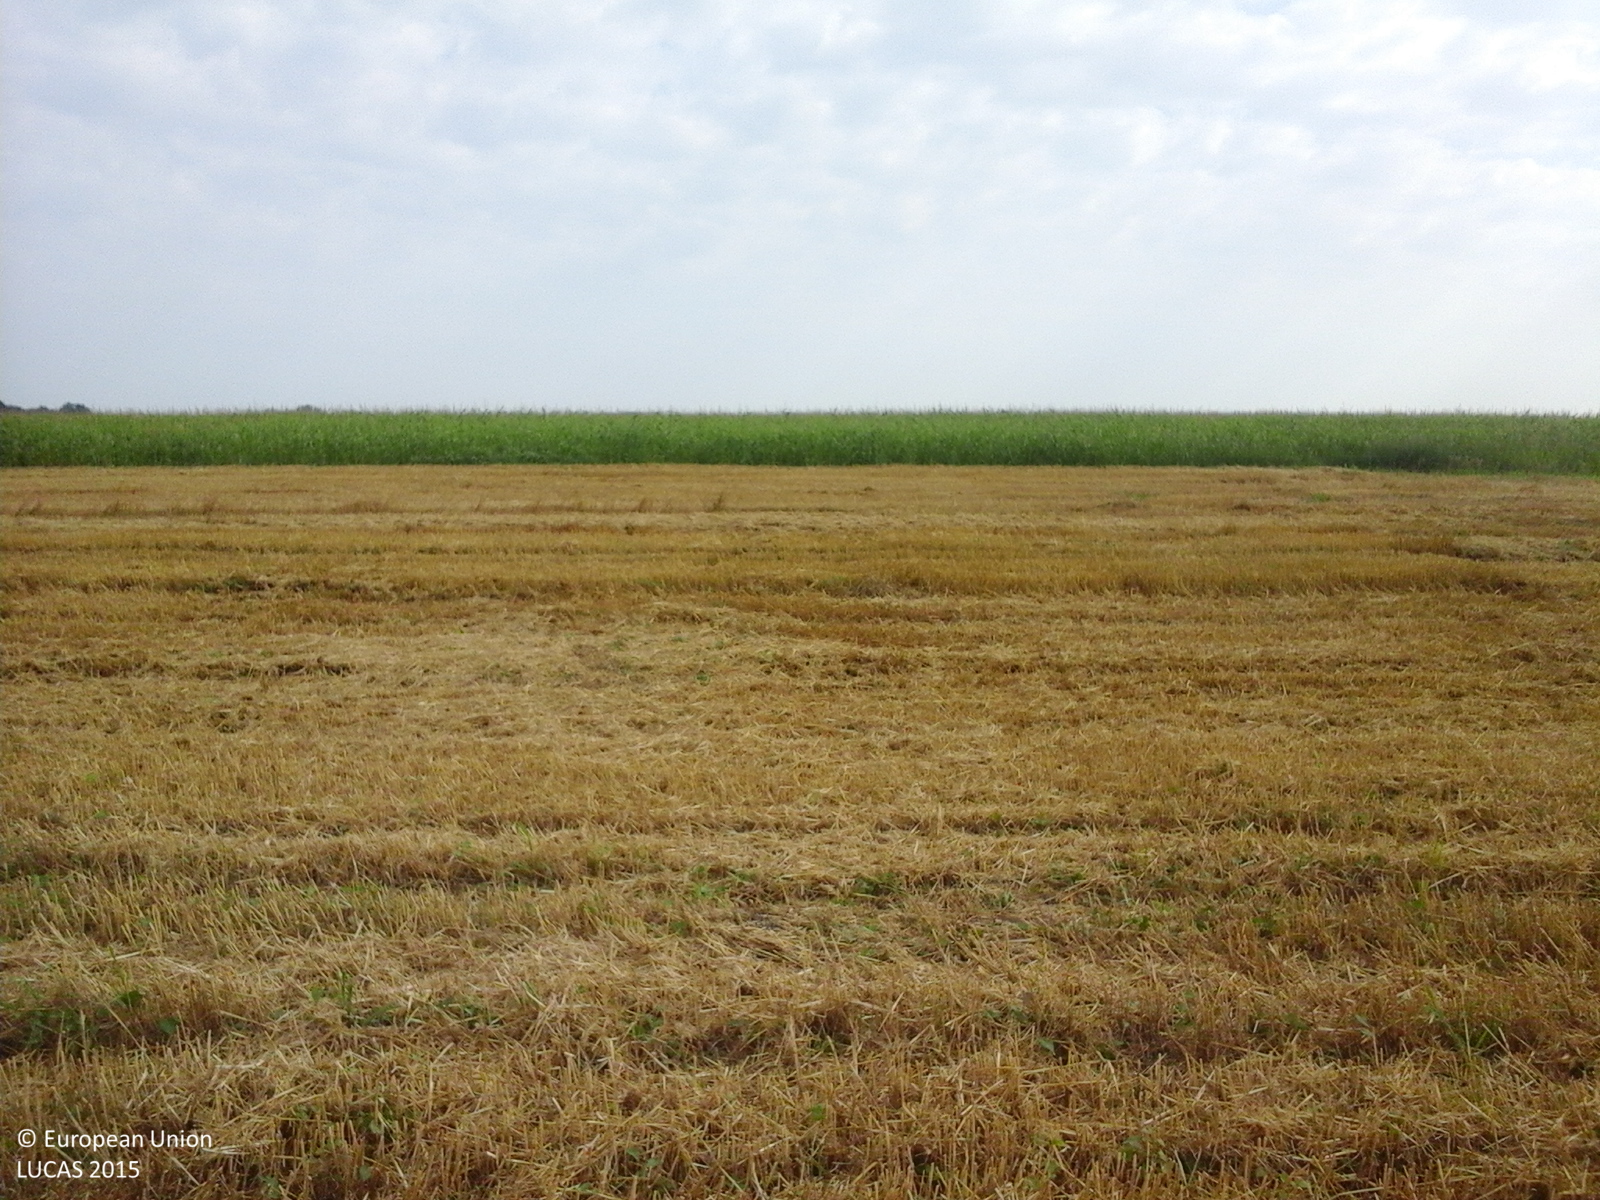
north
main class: Cropland
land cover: Durum wheat
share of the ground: < 10 %
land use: Agriculture (excluding fallow land and kitchen gardens)
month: July
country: RO
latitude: 44.5811
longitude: 26.8382
